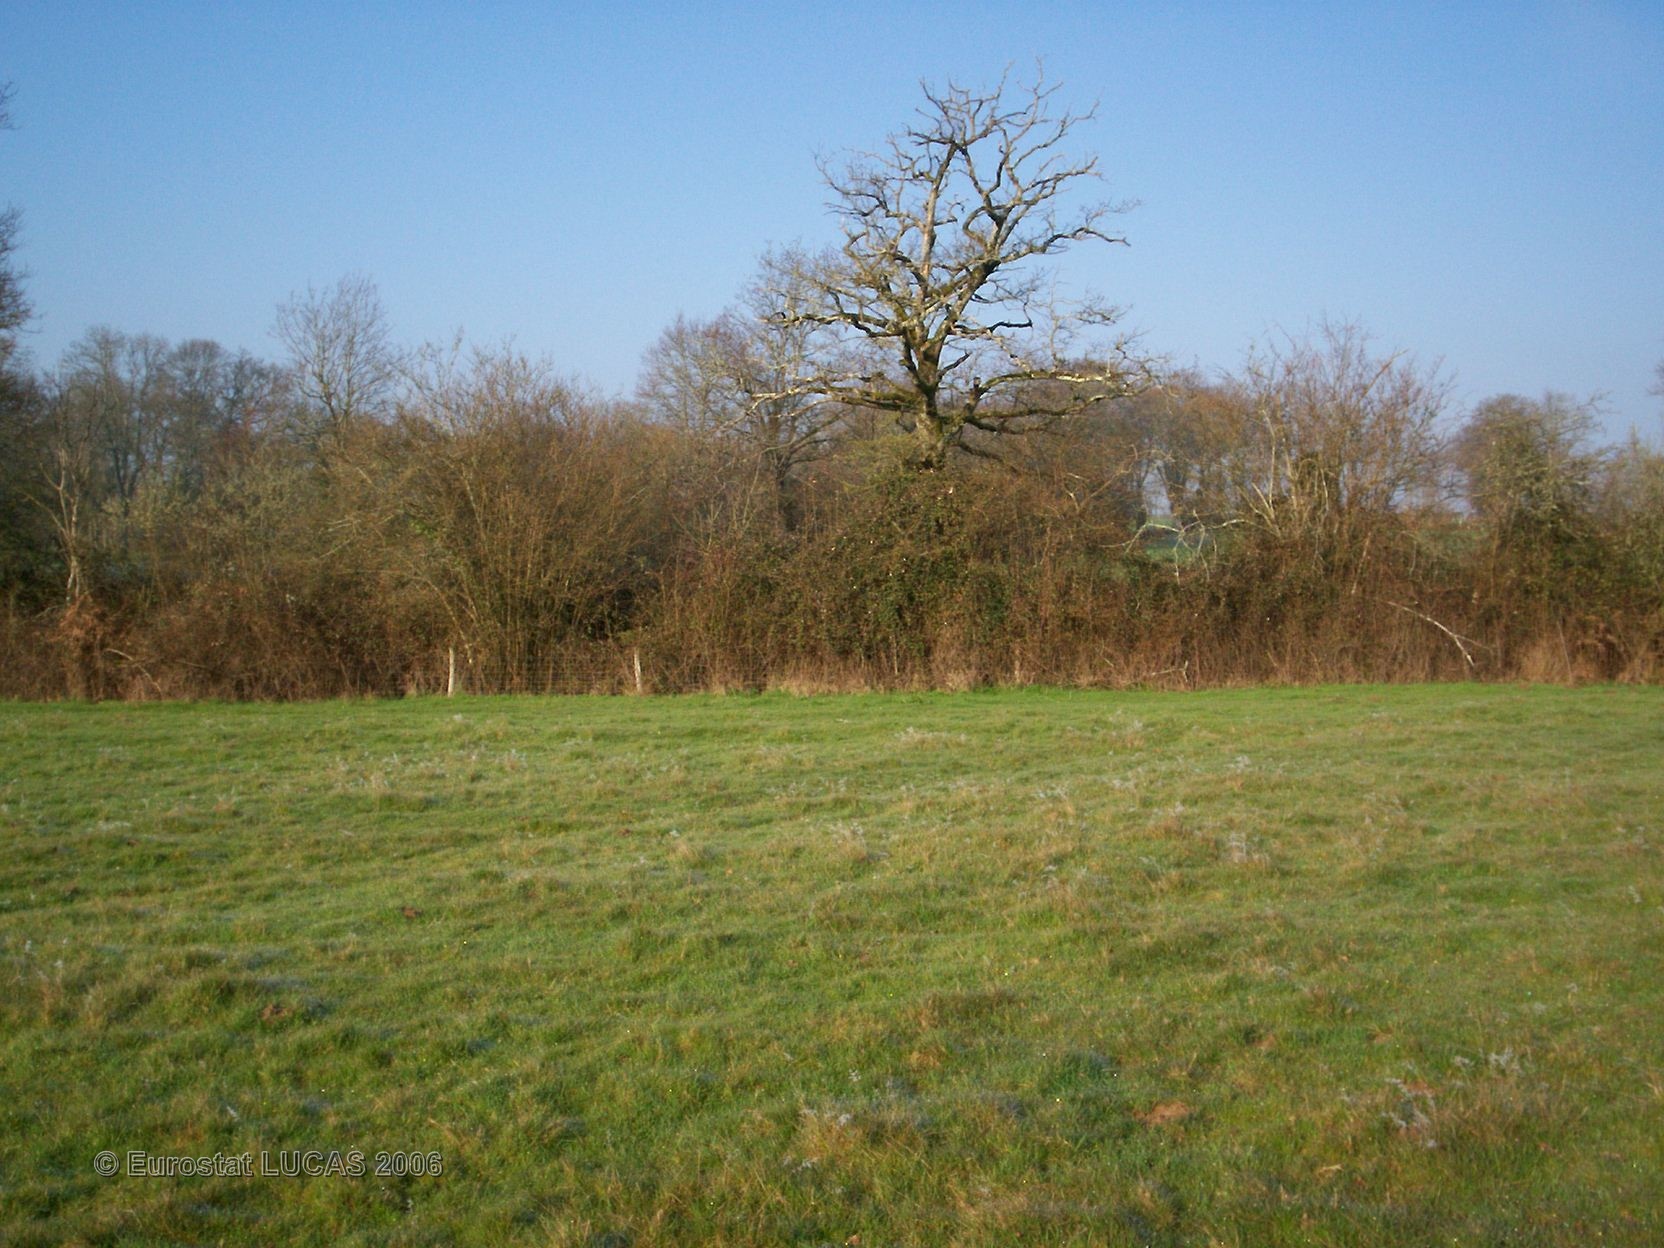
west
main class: Grassland
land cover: Grassland without tree/shrub cover
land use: Agriculture (excluding fallow land and kitchen gardens)
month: April
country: FR
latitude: 46.2516
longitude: 1.1027
